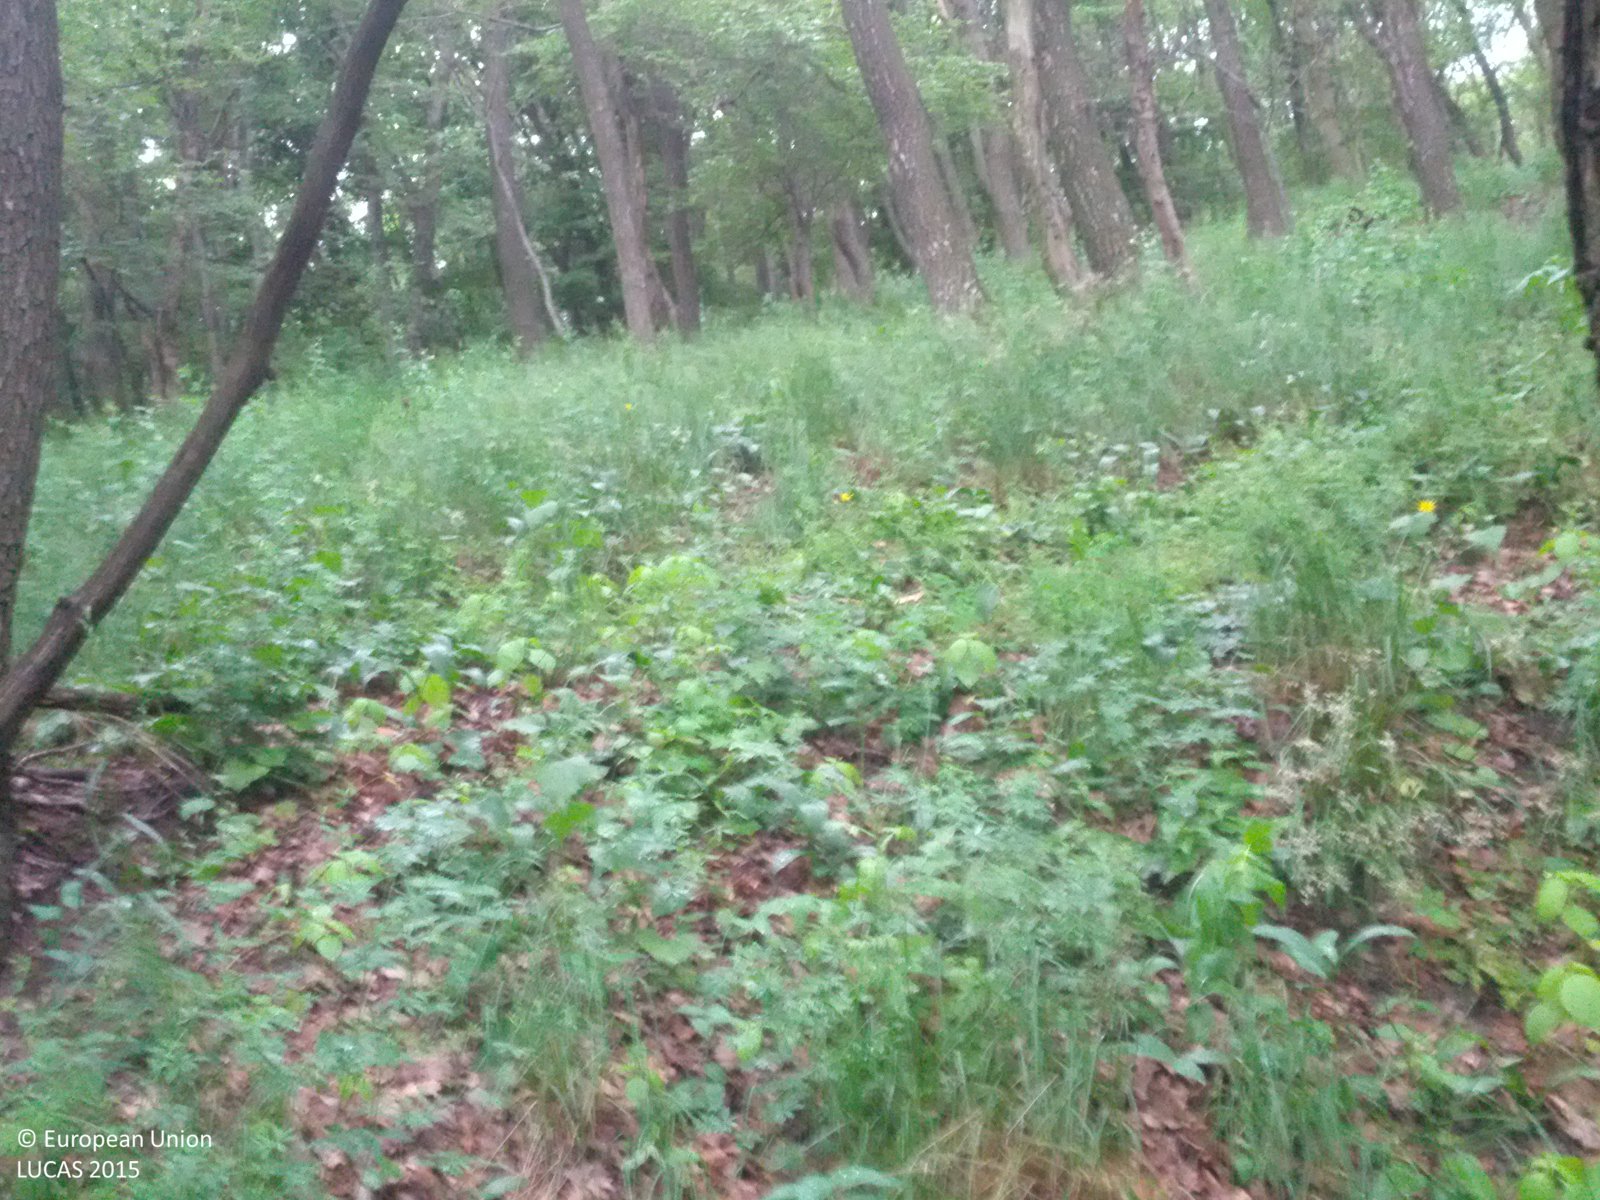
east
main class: Woodland
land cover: Broadleaved woodland
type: beech forest
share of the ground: > 75 %
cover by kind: broadleaved forest trees 90 %, herbaceous plants 10 %
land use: Forestry
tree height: > 5 m
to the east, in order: Broadleaved woodland; Spruce dominated coniferous woodland; Spruce dominated mixed woodland; Broadleaved woodland
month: May
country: AT
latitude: 48.2872
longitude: 16.1365
